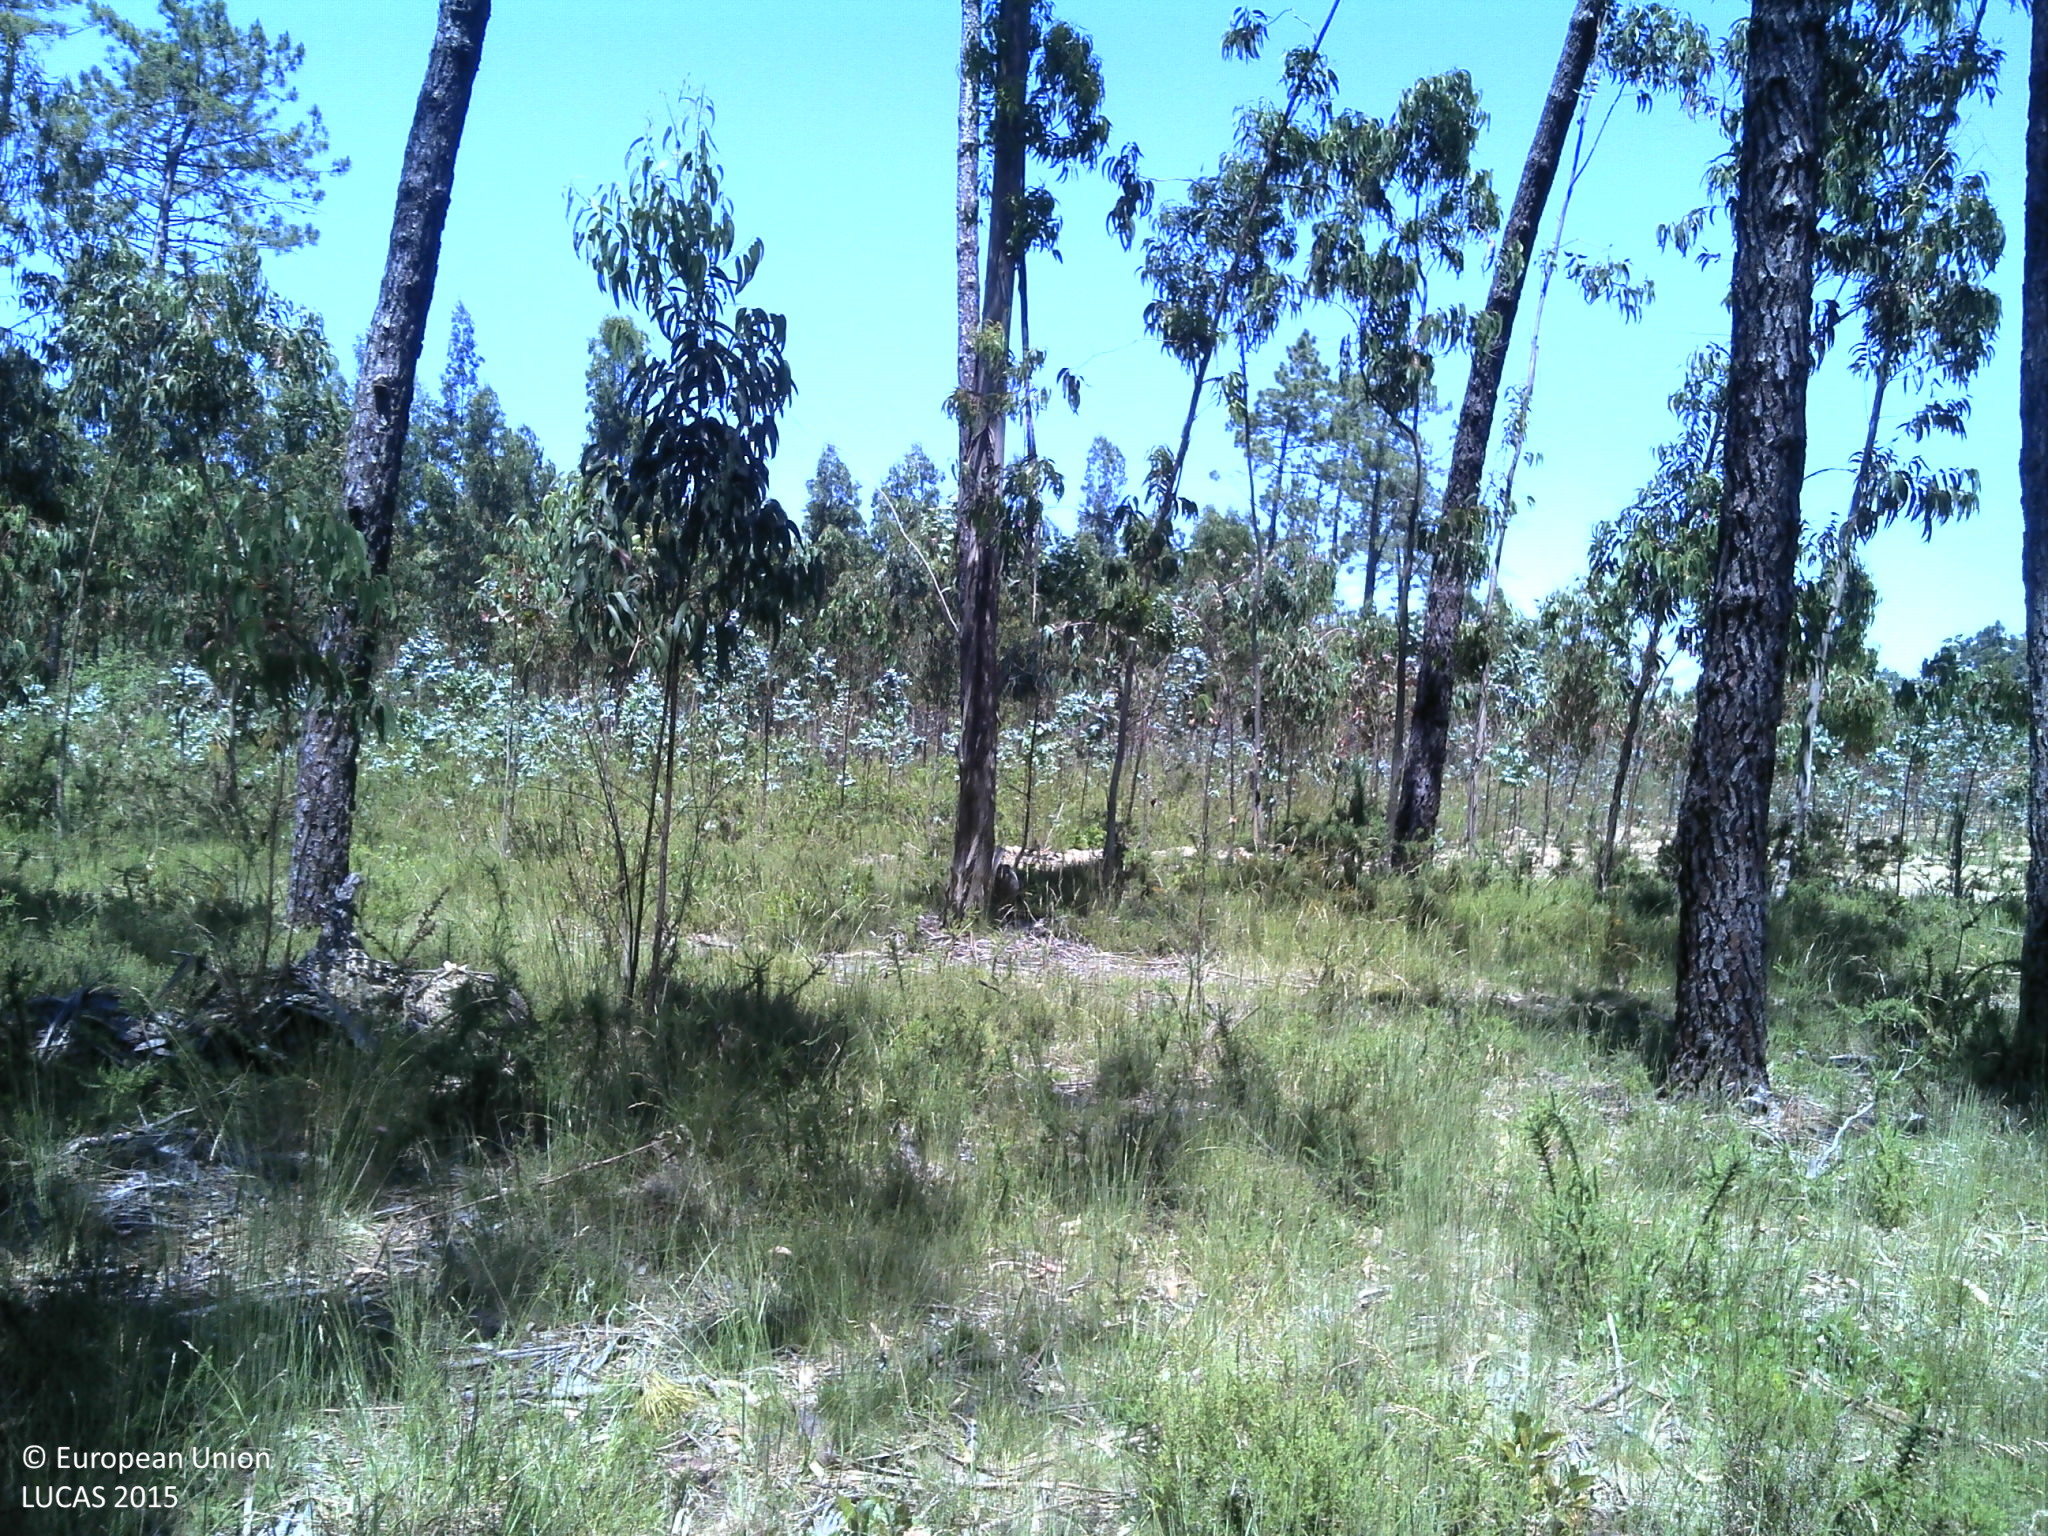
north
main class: Woodland
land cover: Pine dominated mixed woodland
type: coniferous forest of the mediterranean region
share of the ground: 25 - 50 %
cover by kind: coniferous forest trees 35 %, shrubs 25 %, broadleaved forest trees 15 %, herbaceous plants 15 %, unconsolidated bare surface 10 %
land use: Forestry
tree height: > 5 m
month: May
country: PT
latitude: 40.5350
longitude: -8.6425
